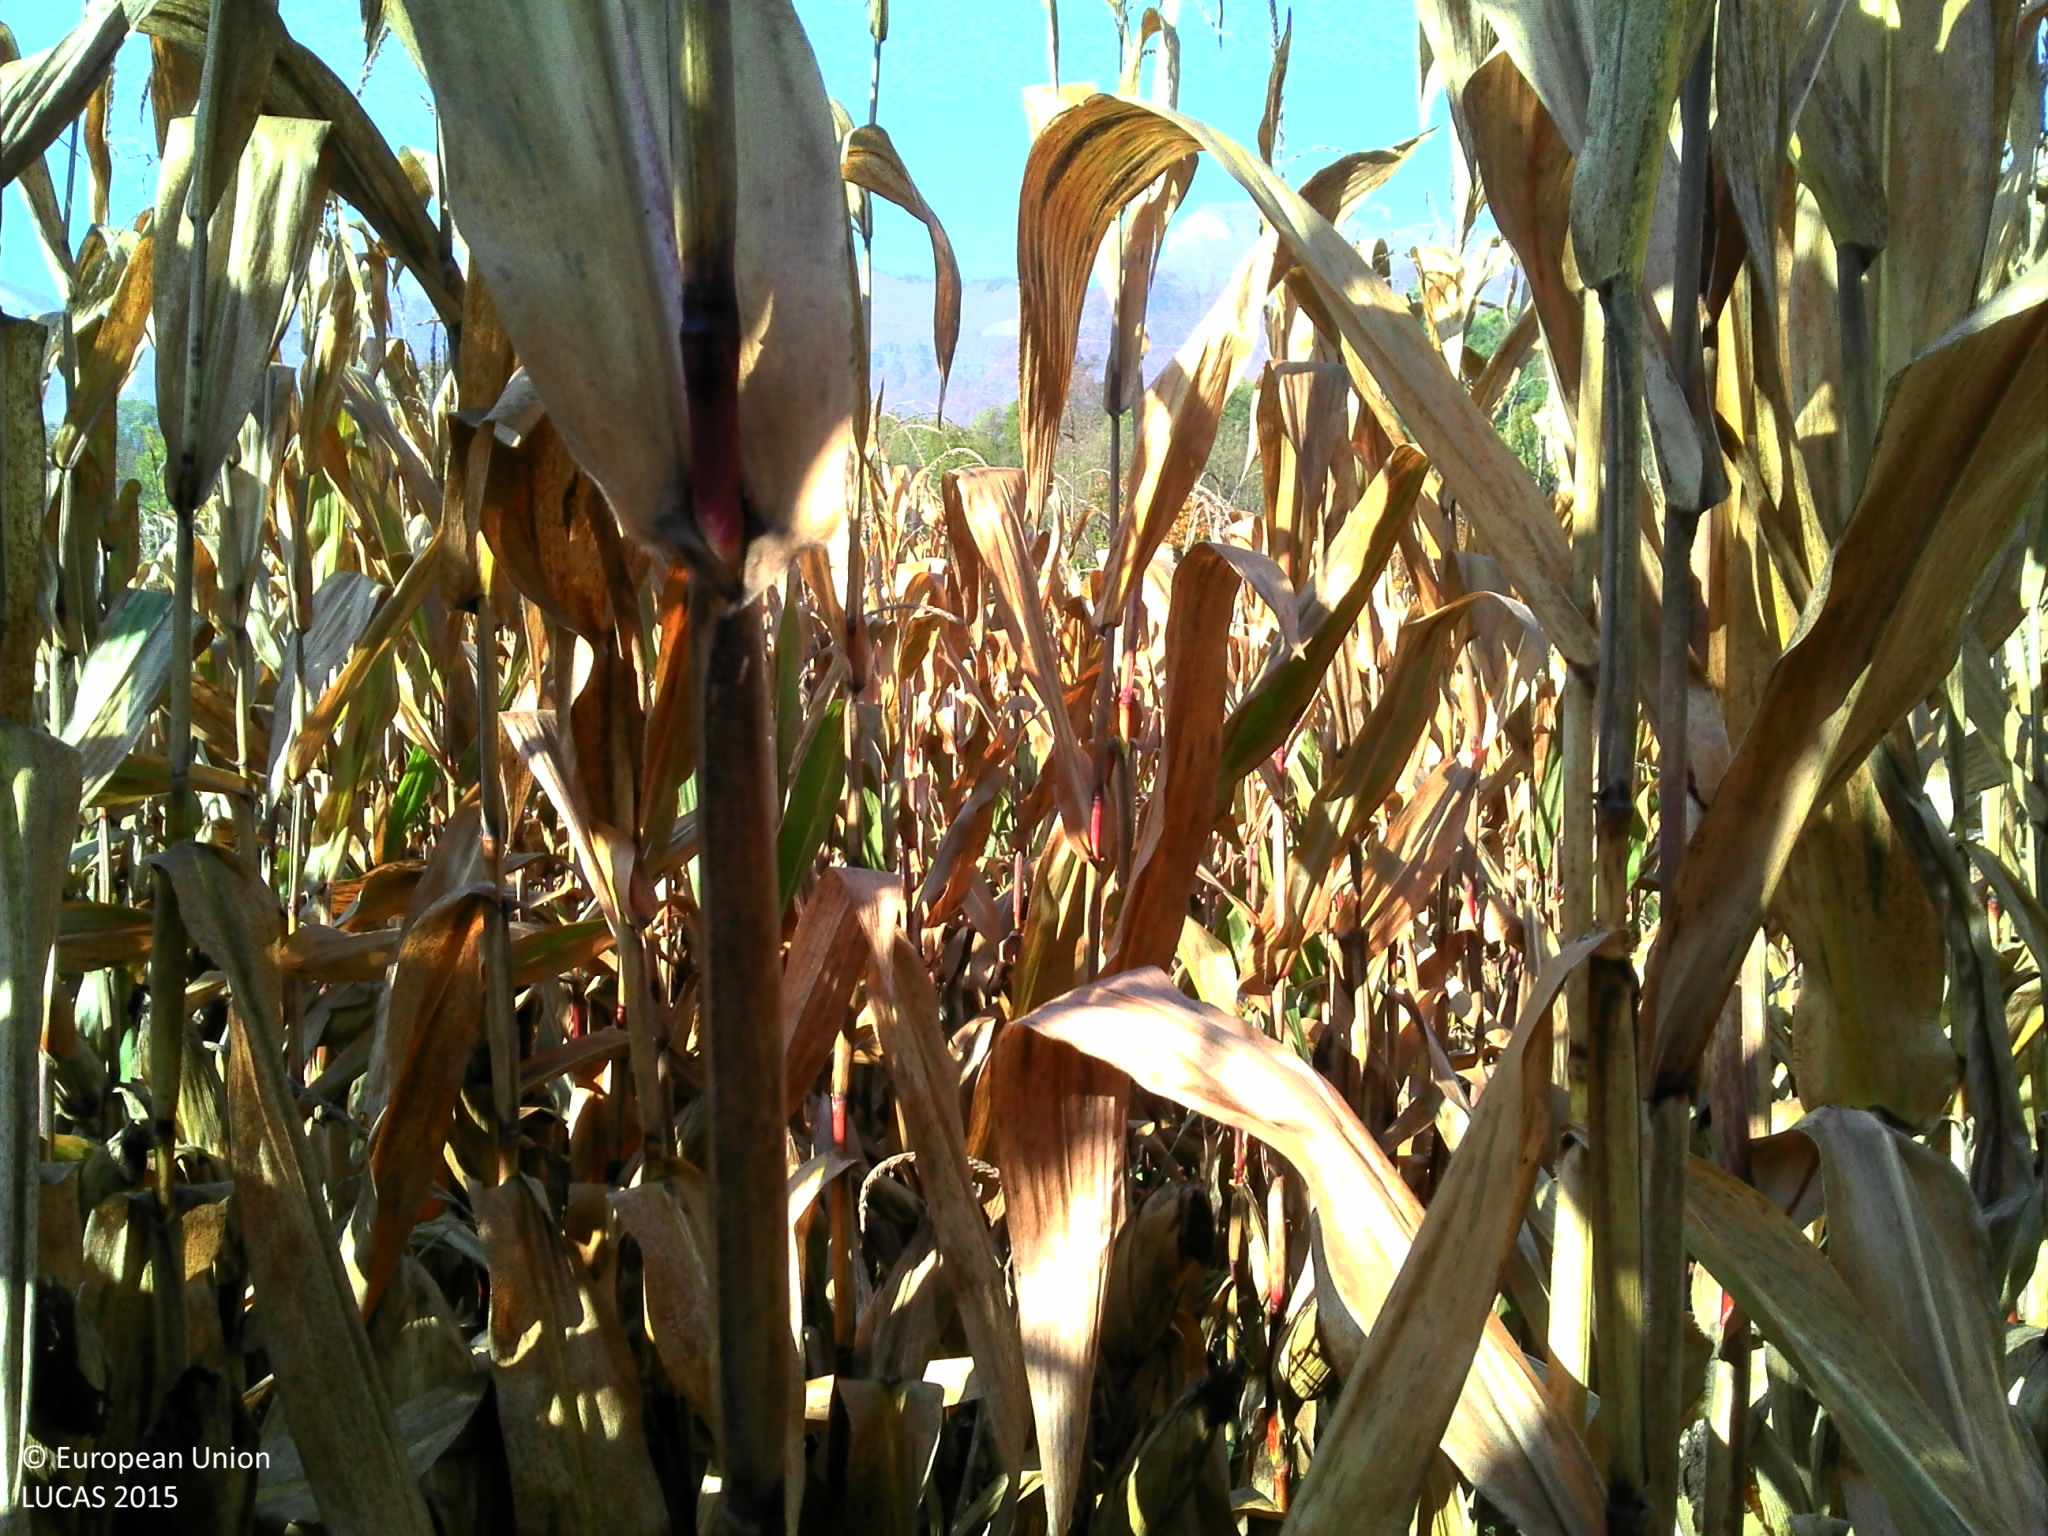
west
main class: Cropland
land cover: Maize
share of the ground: > 75 %
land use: Agriculture (excluding fallow land and kitchen gardens)
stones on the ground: < 10 %
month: October
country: FR
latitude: 45.6388
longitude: 6.3224
